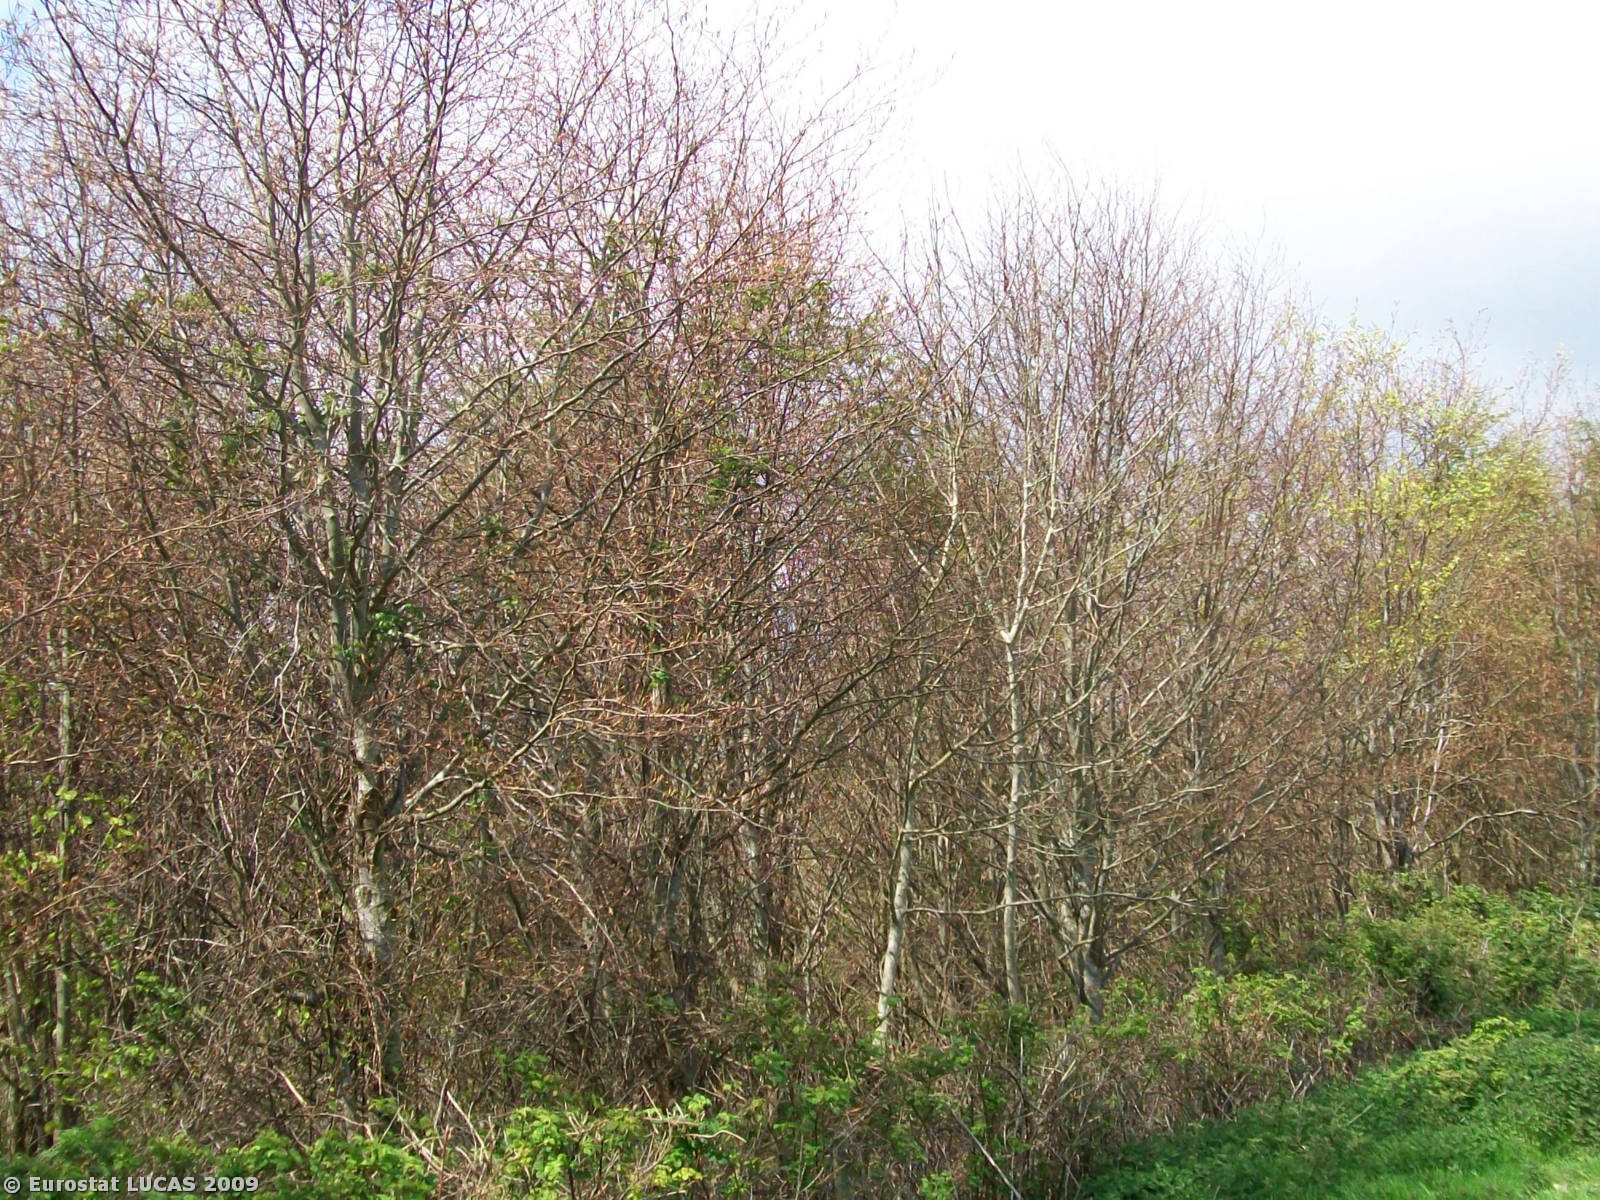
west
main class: Woodland
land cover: Broadleaved woodland
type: mesophytic deciduous forest
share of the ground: 25 - 50 %
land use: Unused
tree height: > 5 m
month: April
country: GB
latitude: 50.6930
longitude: -3.3165
